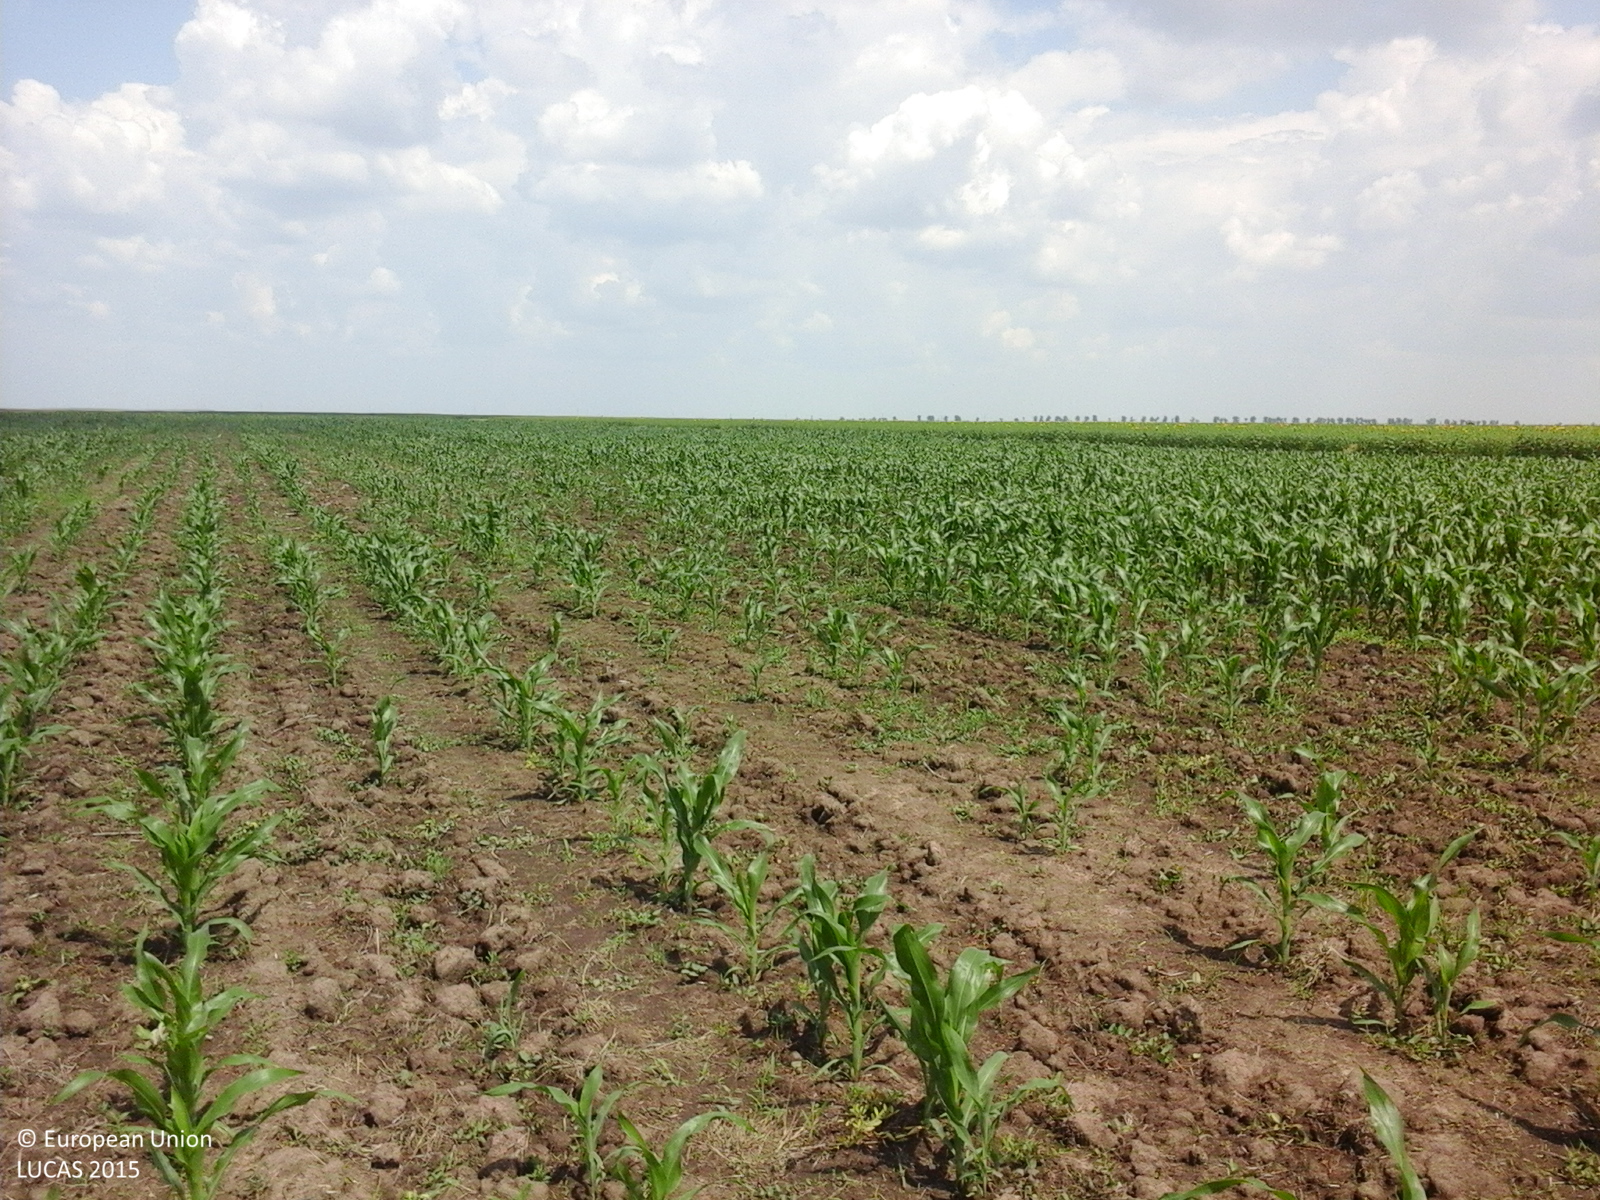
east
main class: Cropland
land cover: Maize
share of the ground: 25 - 50 %
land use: Agriculture (excluding fallow land and kitchen gardens)
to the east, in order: Maize; Sunflower
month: July
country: RO
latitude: 44.0339
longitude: 25.2934
